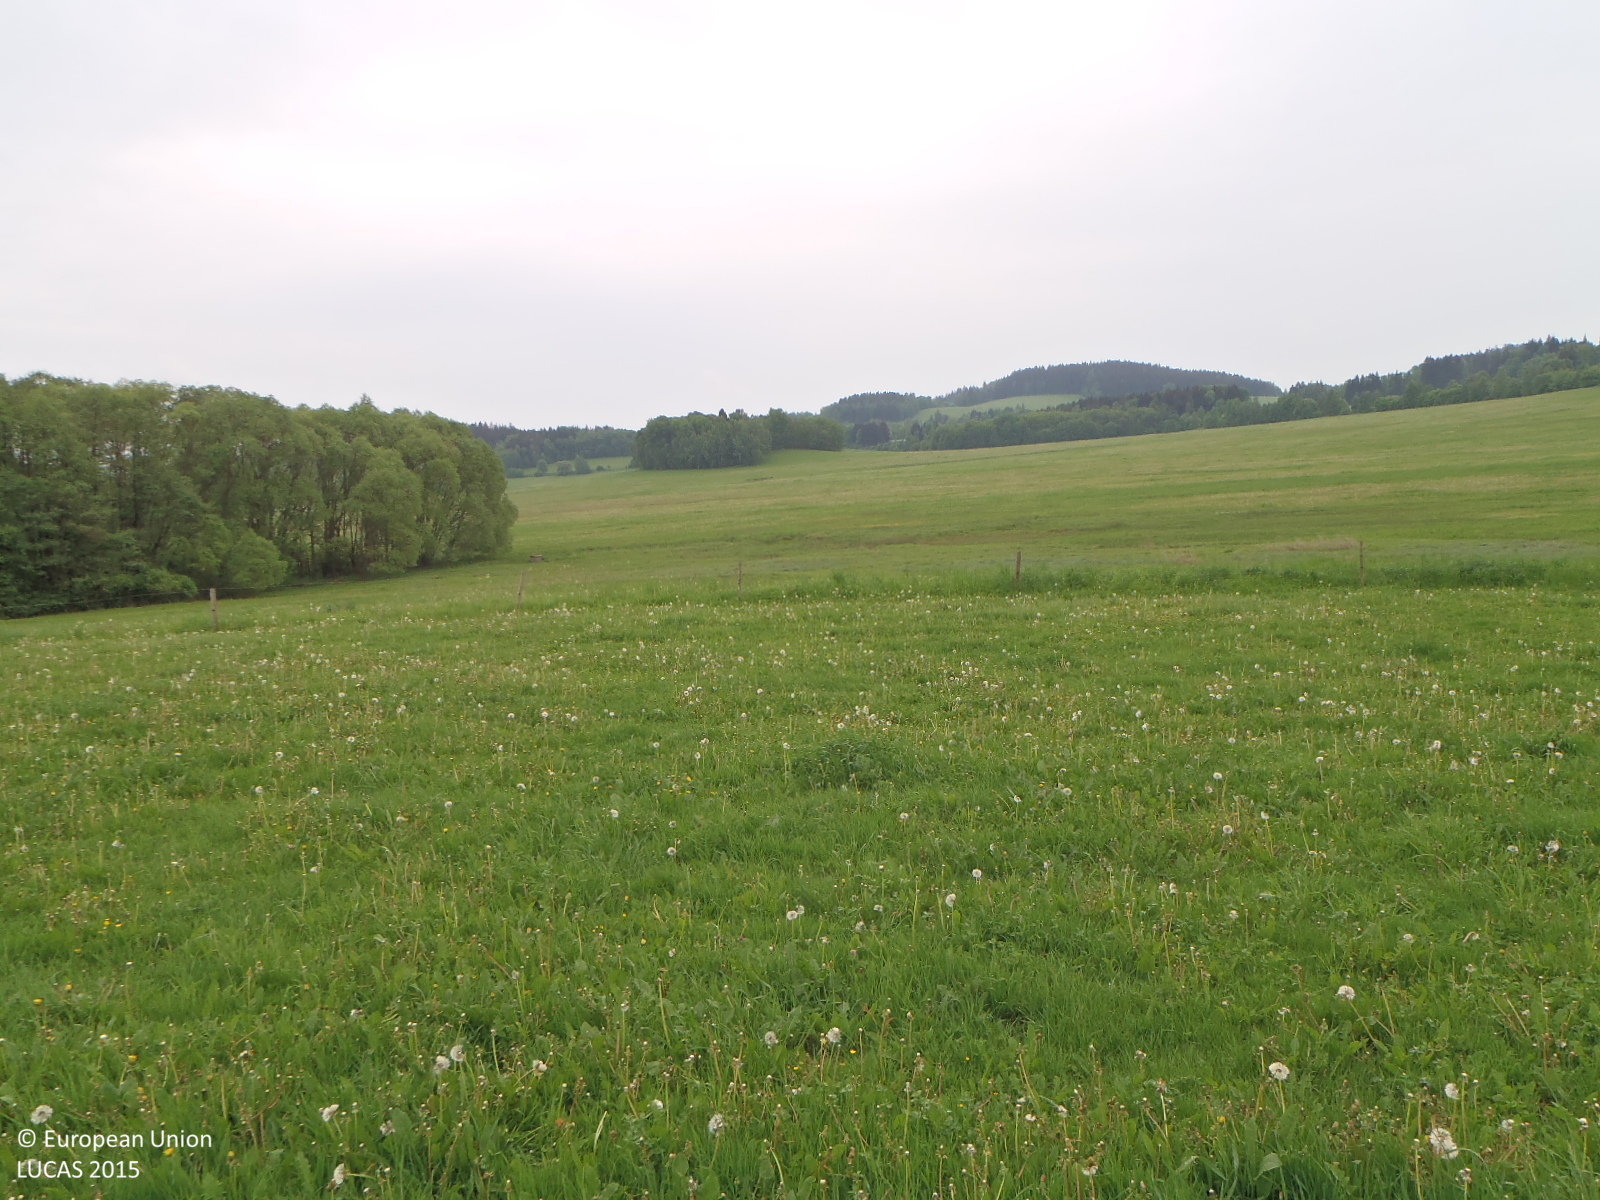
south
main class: Grassland
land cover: Grassland without tree/shrub cover
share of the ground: > 75 %
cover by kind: herbaceous plants 95 %, unconsolidated bare surface 5 %
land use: Agriculture (excluding fallow land and kitchen gardens)
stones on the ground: < 10 %
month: May
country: CZ
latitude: 48.7296
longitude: 14.4192
